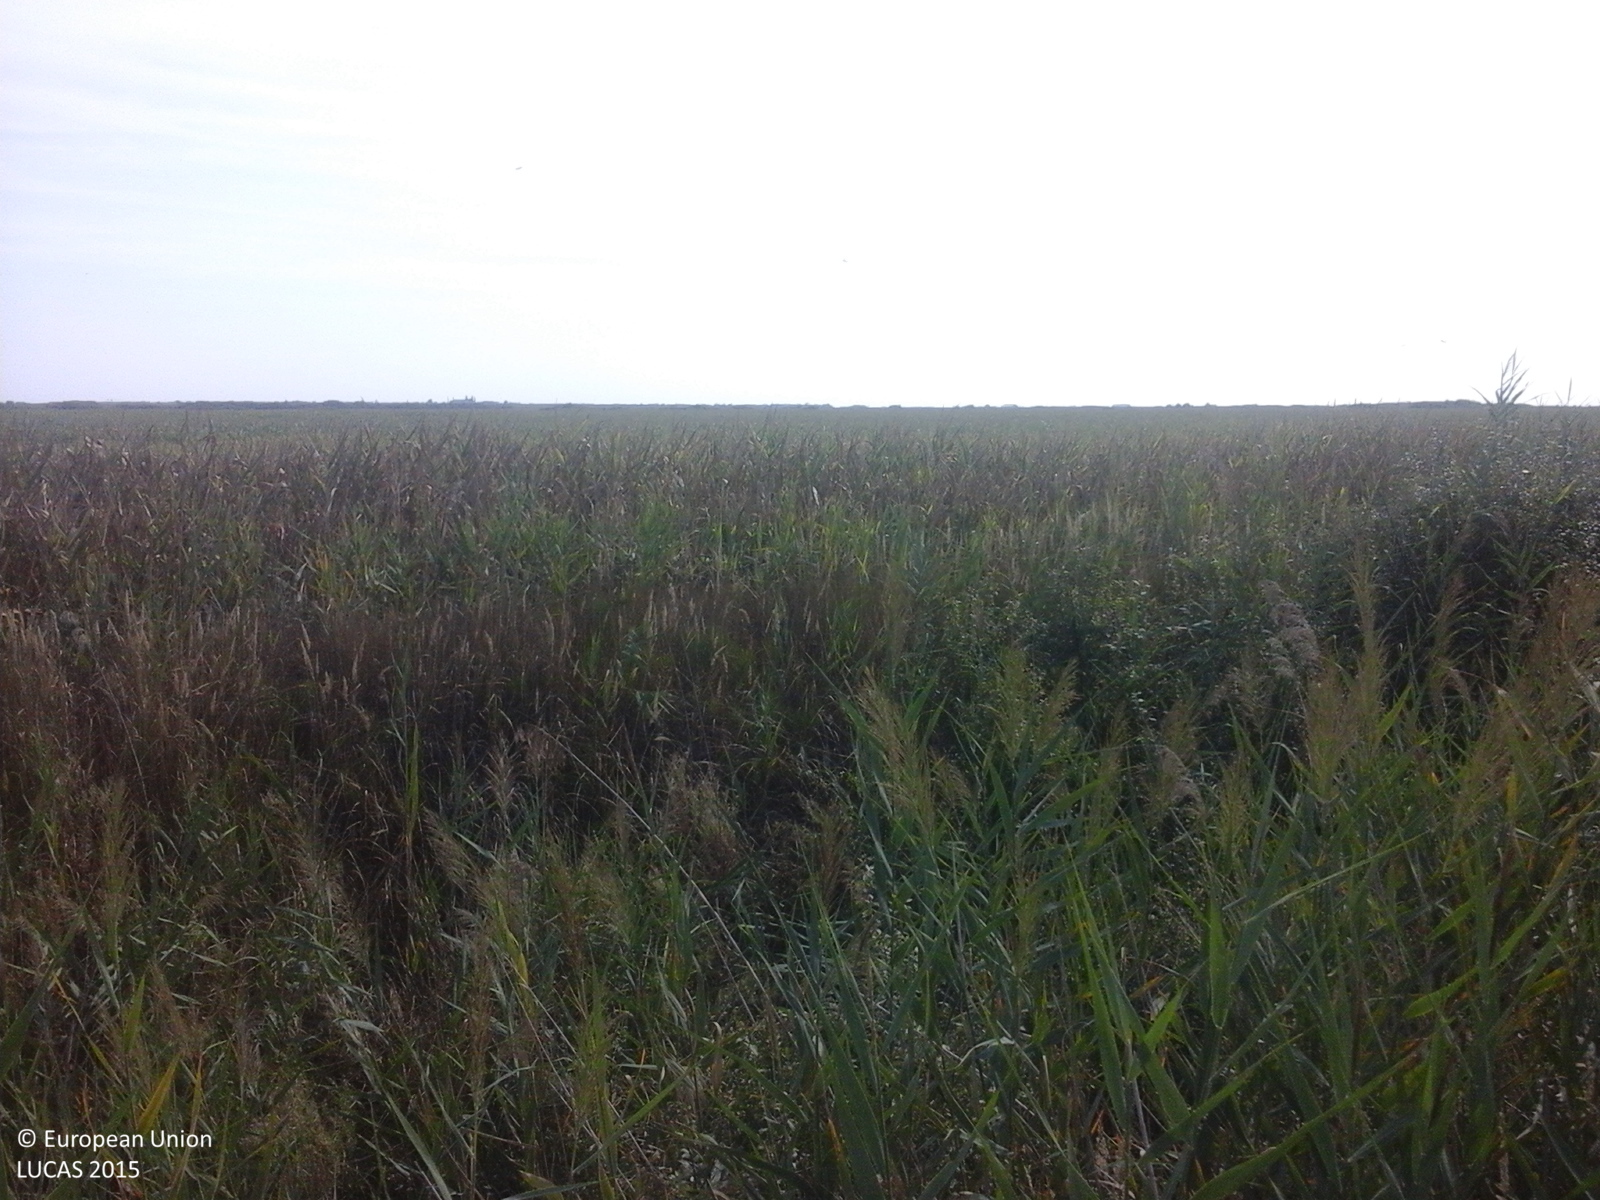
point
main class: Cropland
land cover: Maize
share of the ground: > 75 %
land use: Agriculture (excluding fallow land and kitchen gardens)
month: August
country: RO
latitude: 45.7412
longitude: 21.0431
